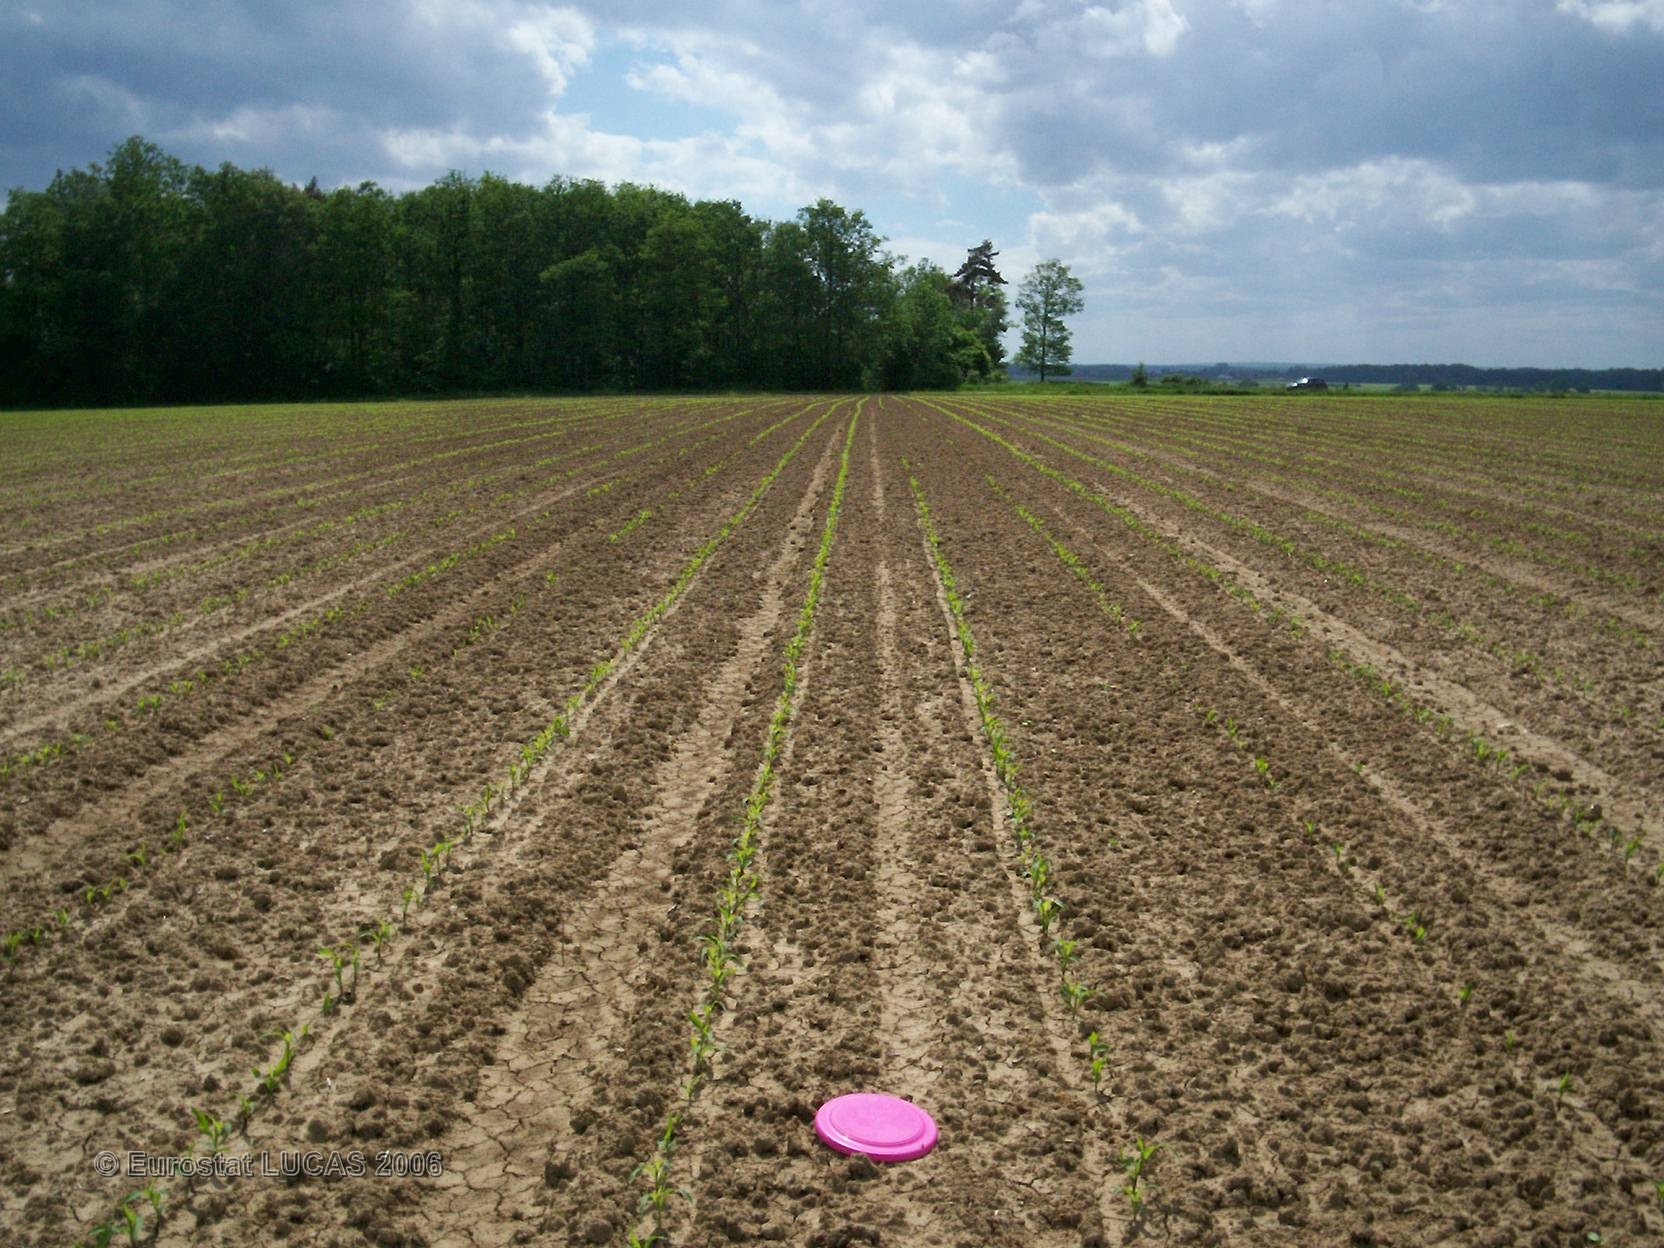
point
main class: Cropland
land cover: Maize
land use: Agriculture (excluding fallow land and kitchen gardens)
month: May
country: FR
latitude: 48.3723
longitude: 4.4489
